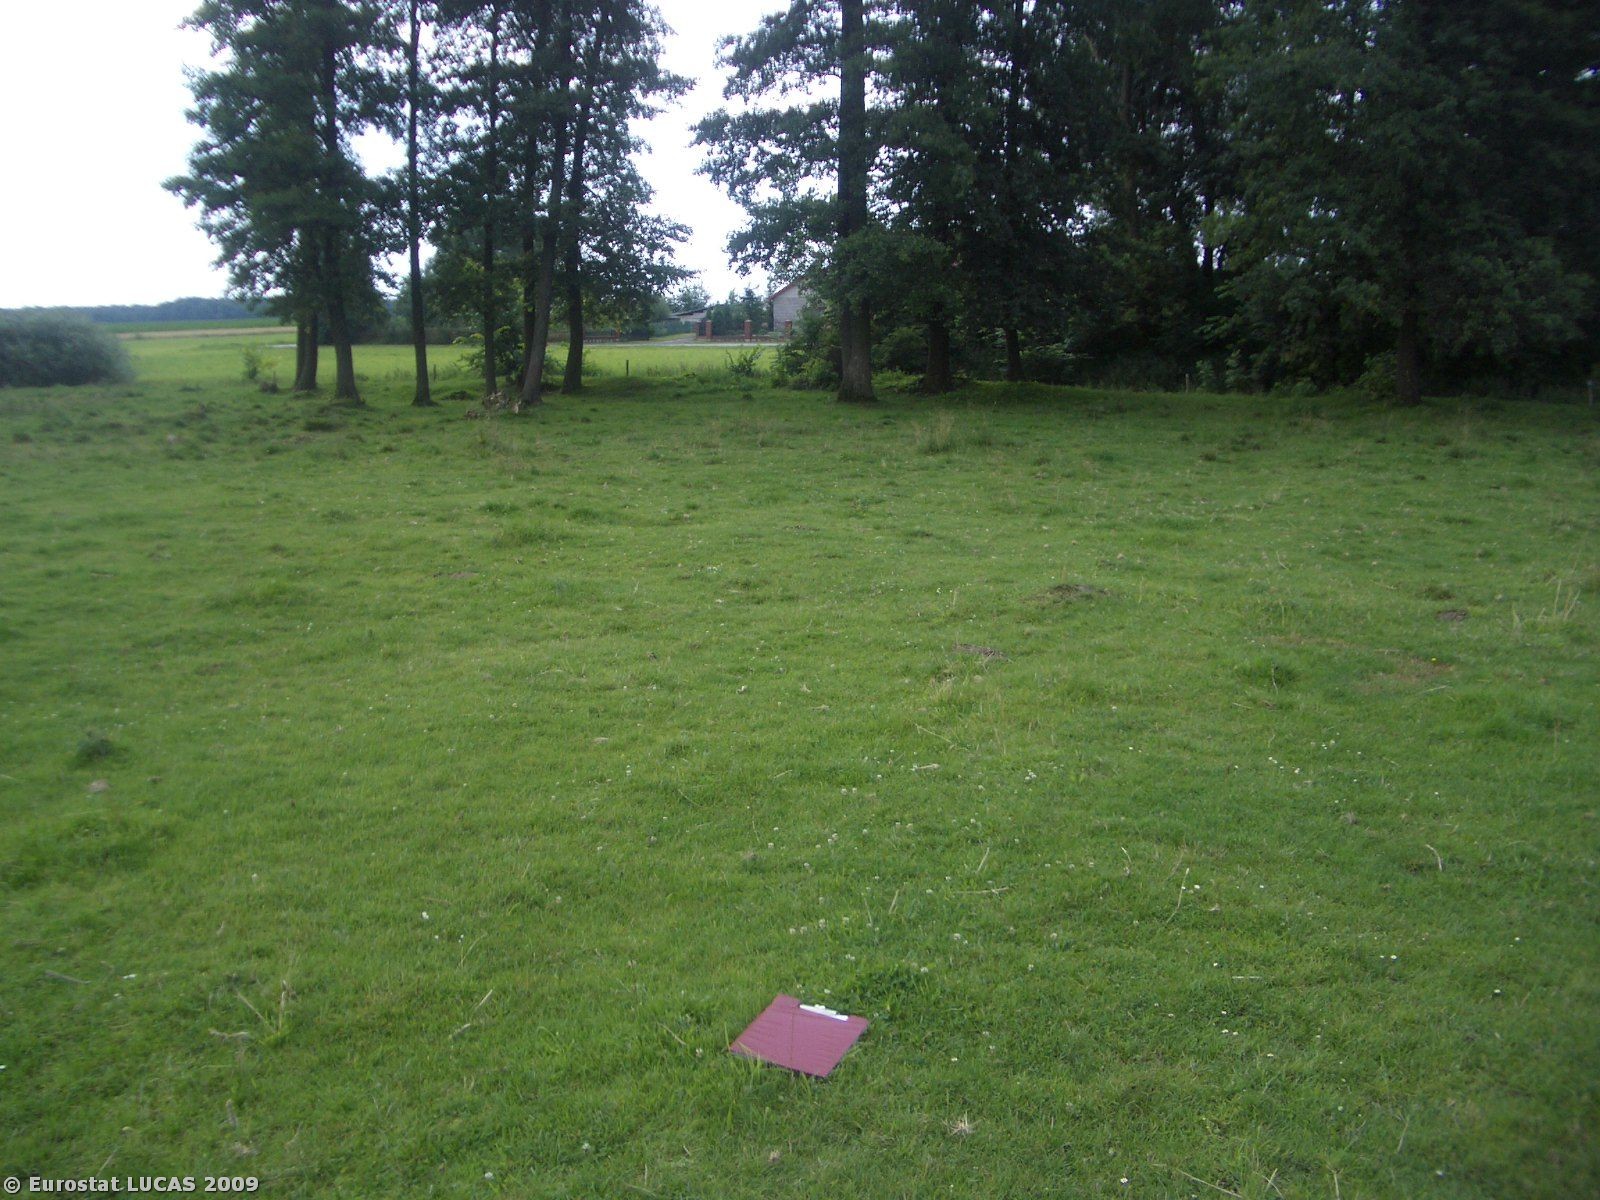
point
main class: Grassland
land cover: Grassland without tree/shrub cover
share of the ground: > 75 %
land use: Agriculture (excluding fallow land and kitchen gardens)
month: July
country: PL
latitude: 52.0140
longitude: 22.5838
